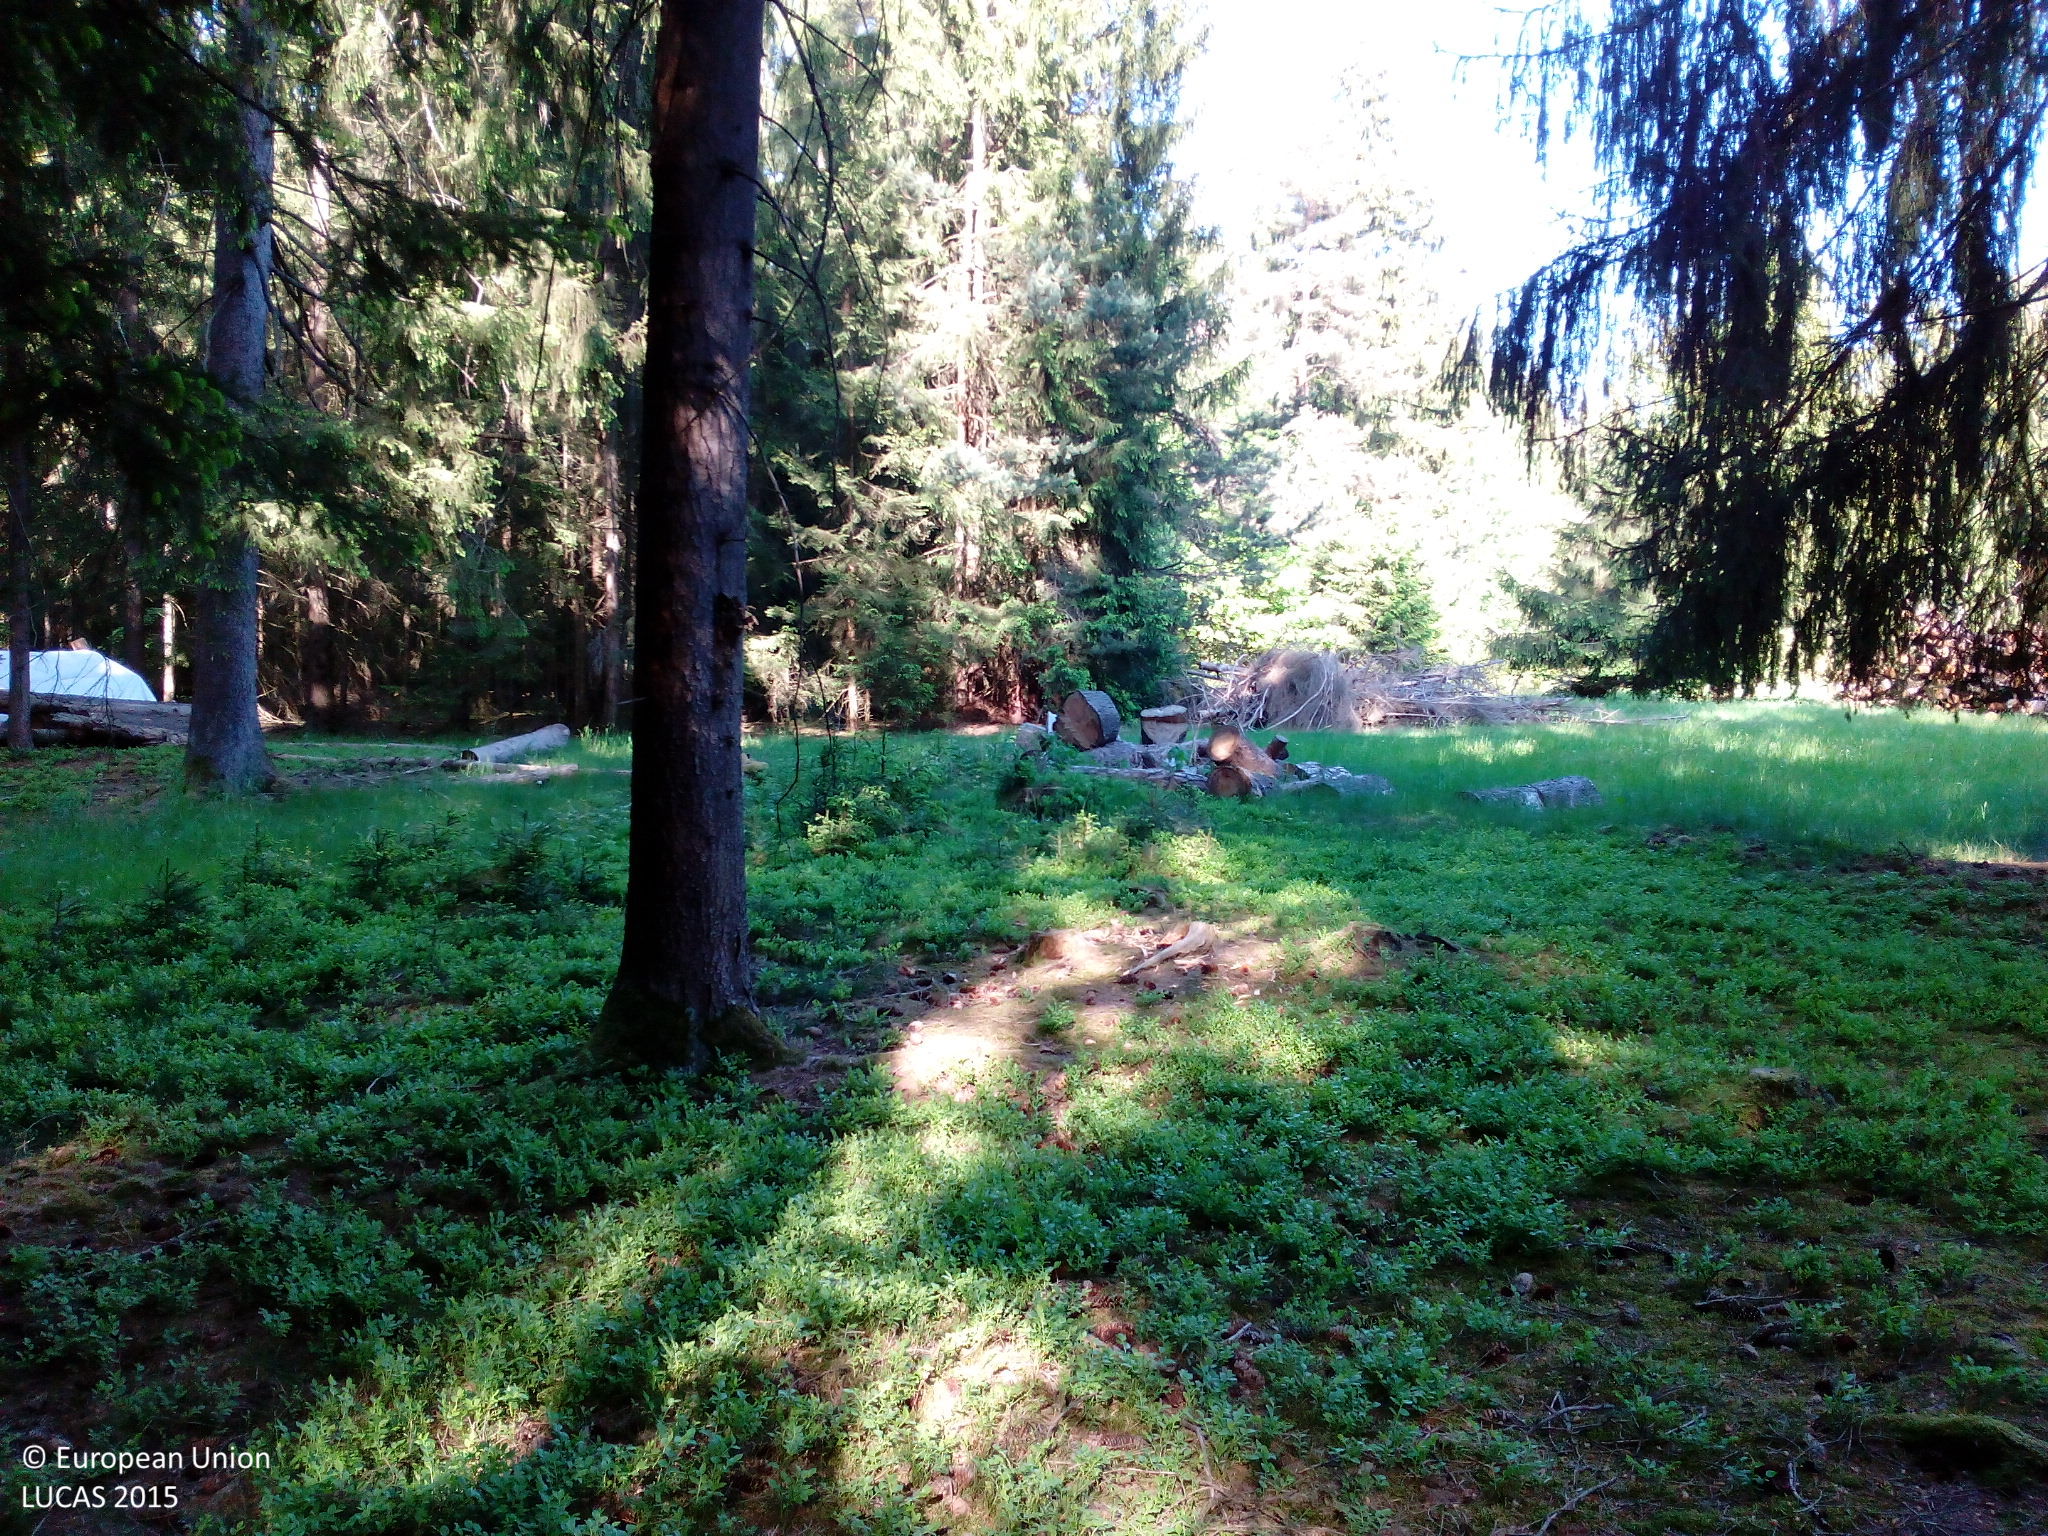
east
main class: Woodland
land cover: Spruce dominated coniferous woodland
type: hemiboreal forest and nemoral coniferous forest and mixed broadleaved-coniferous forest
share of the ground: > 75 %
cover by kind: coniferous forest trees 95 %, herbaceous plants 5 %
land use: Forestry
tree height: > 5 m
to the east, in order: Spruce dominated coniferous woodland; Grassland with sparse tree/shrub cover; Spruce dominated coniferous woodland; Tracks; Spruce dominated coniferous woodland; Tracks; Spruce dominated coniferous woodland
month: May
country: DE
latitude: 49.4189
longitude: 11.5021
